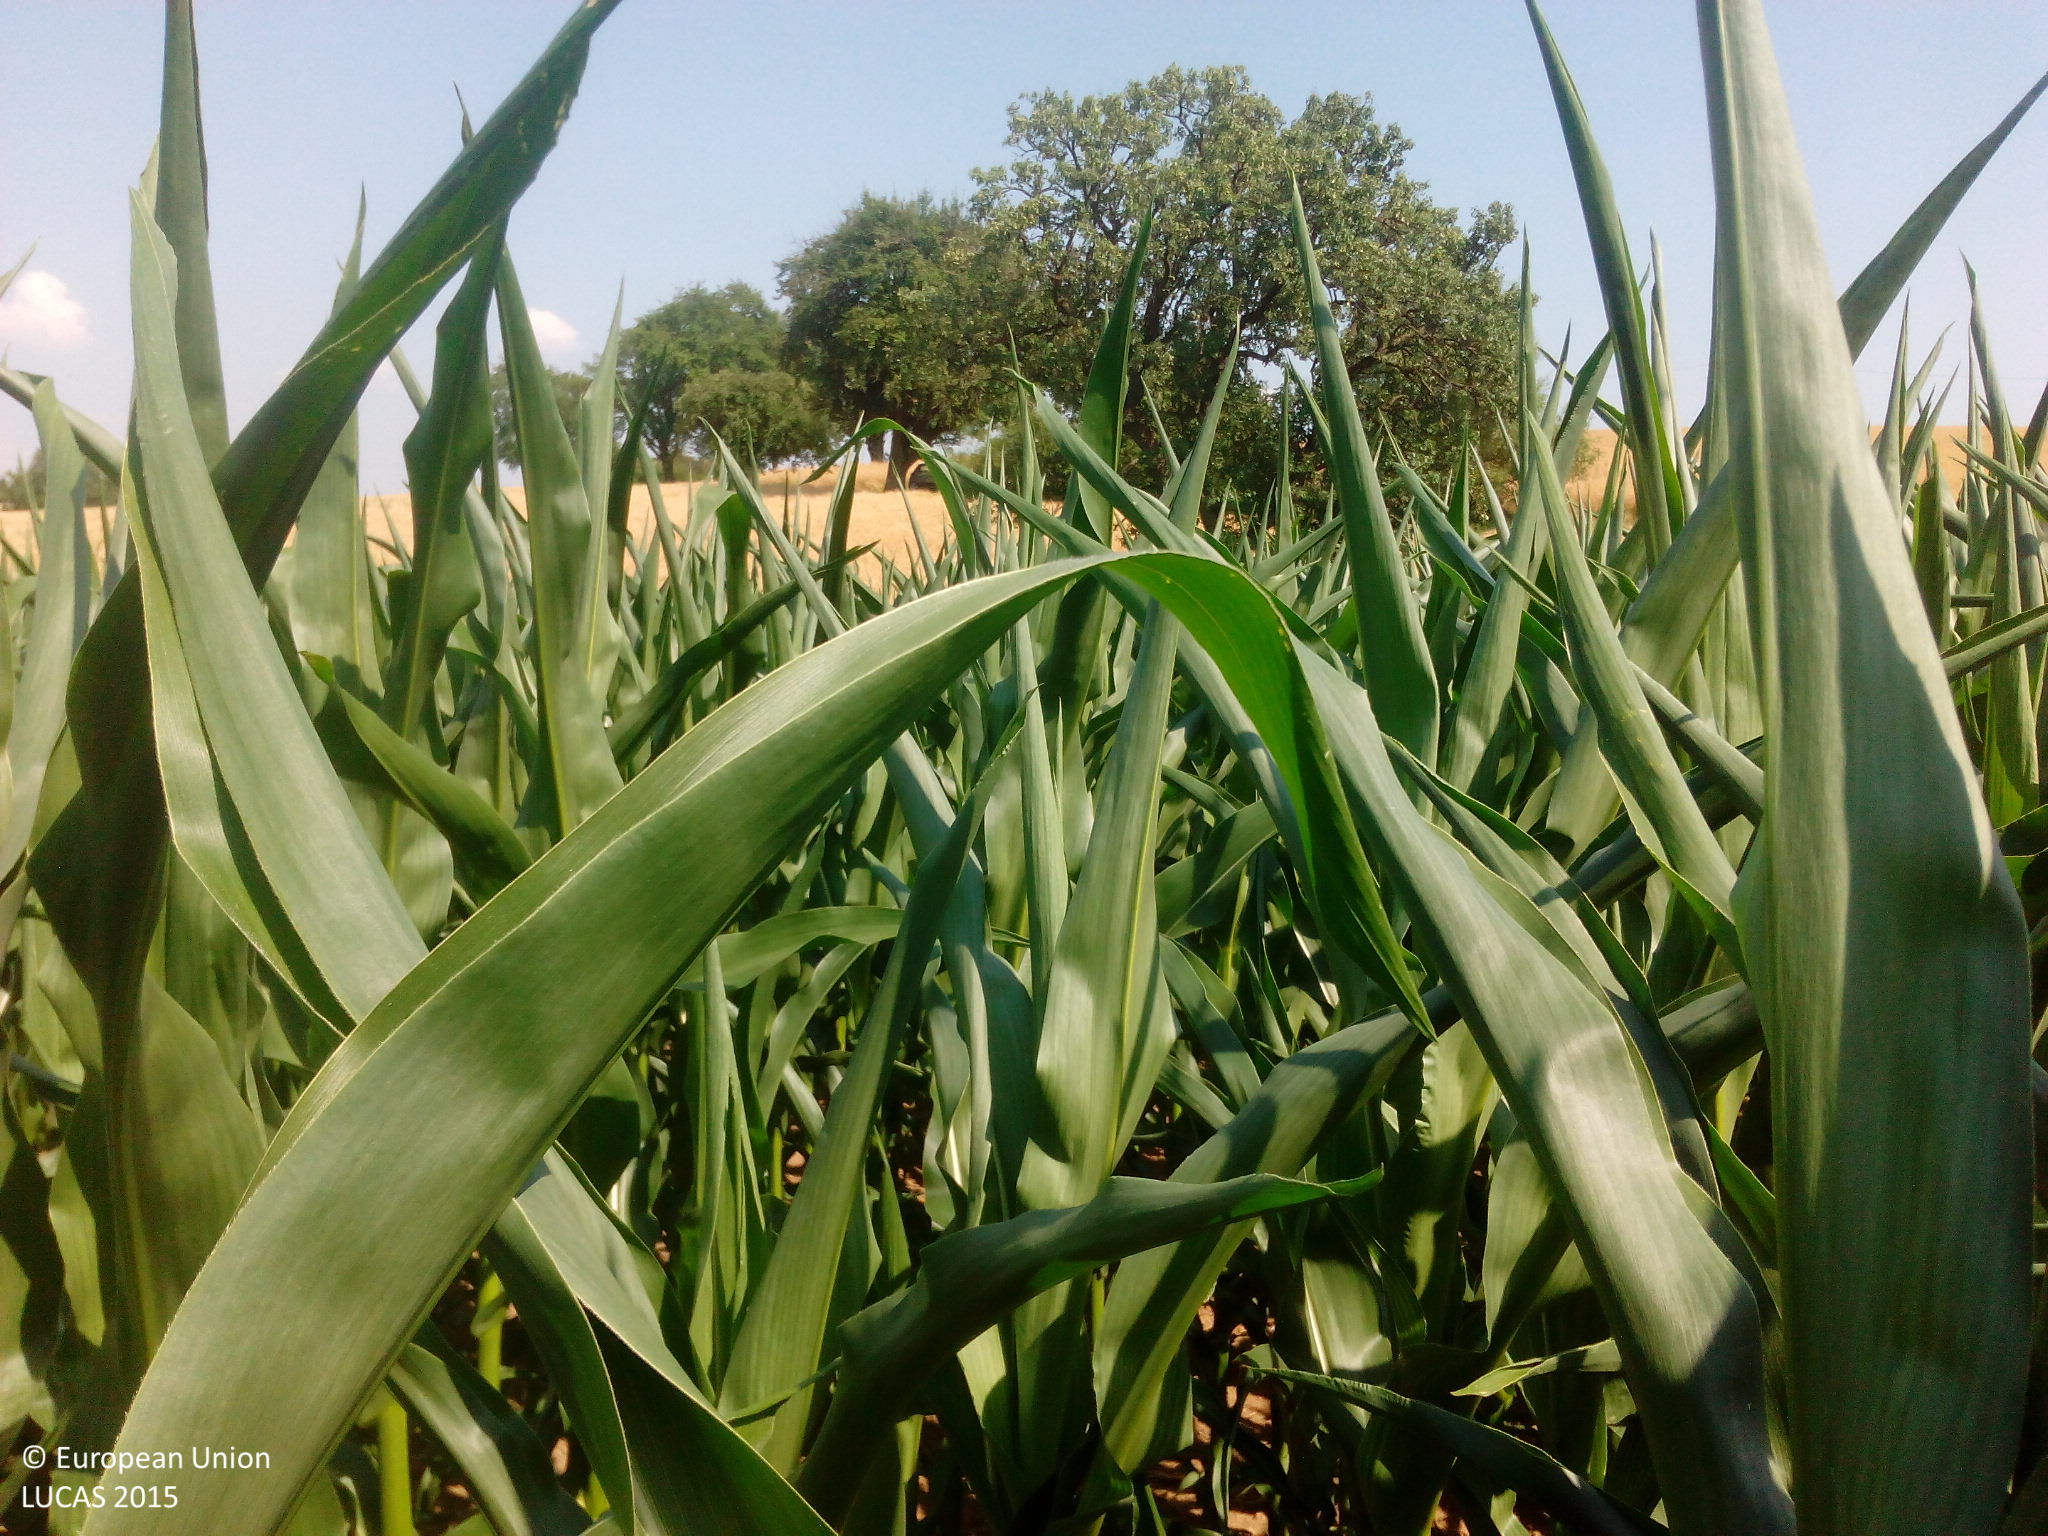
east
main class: Cropland
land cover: Maize
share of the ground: > 75 %
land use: Agriculture (excluding fallow land and kitchen gardens)
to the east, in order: Maize; Grassland without tree/shrub cover; Ditches and canals; Lines of trees; Grassland without tree/shrub cover; Barley; Grass margins; Tracks; Grassland with sparse tree/shrub cover; Paved roads, cycling and walking lanes; Grass margins; Ditches and canals; Electric lines; Broadleaved woodland; Grass margins; Tracks; Grass margins; Barley
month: July
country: DE
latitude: 49.4468
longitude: 9.9035
